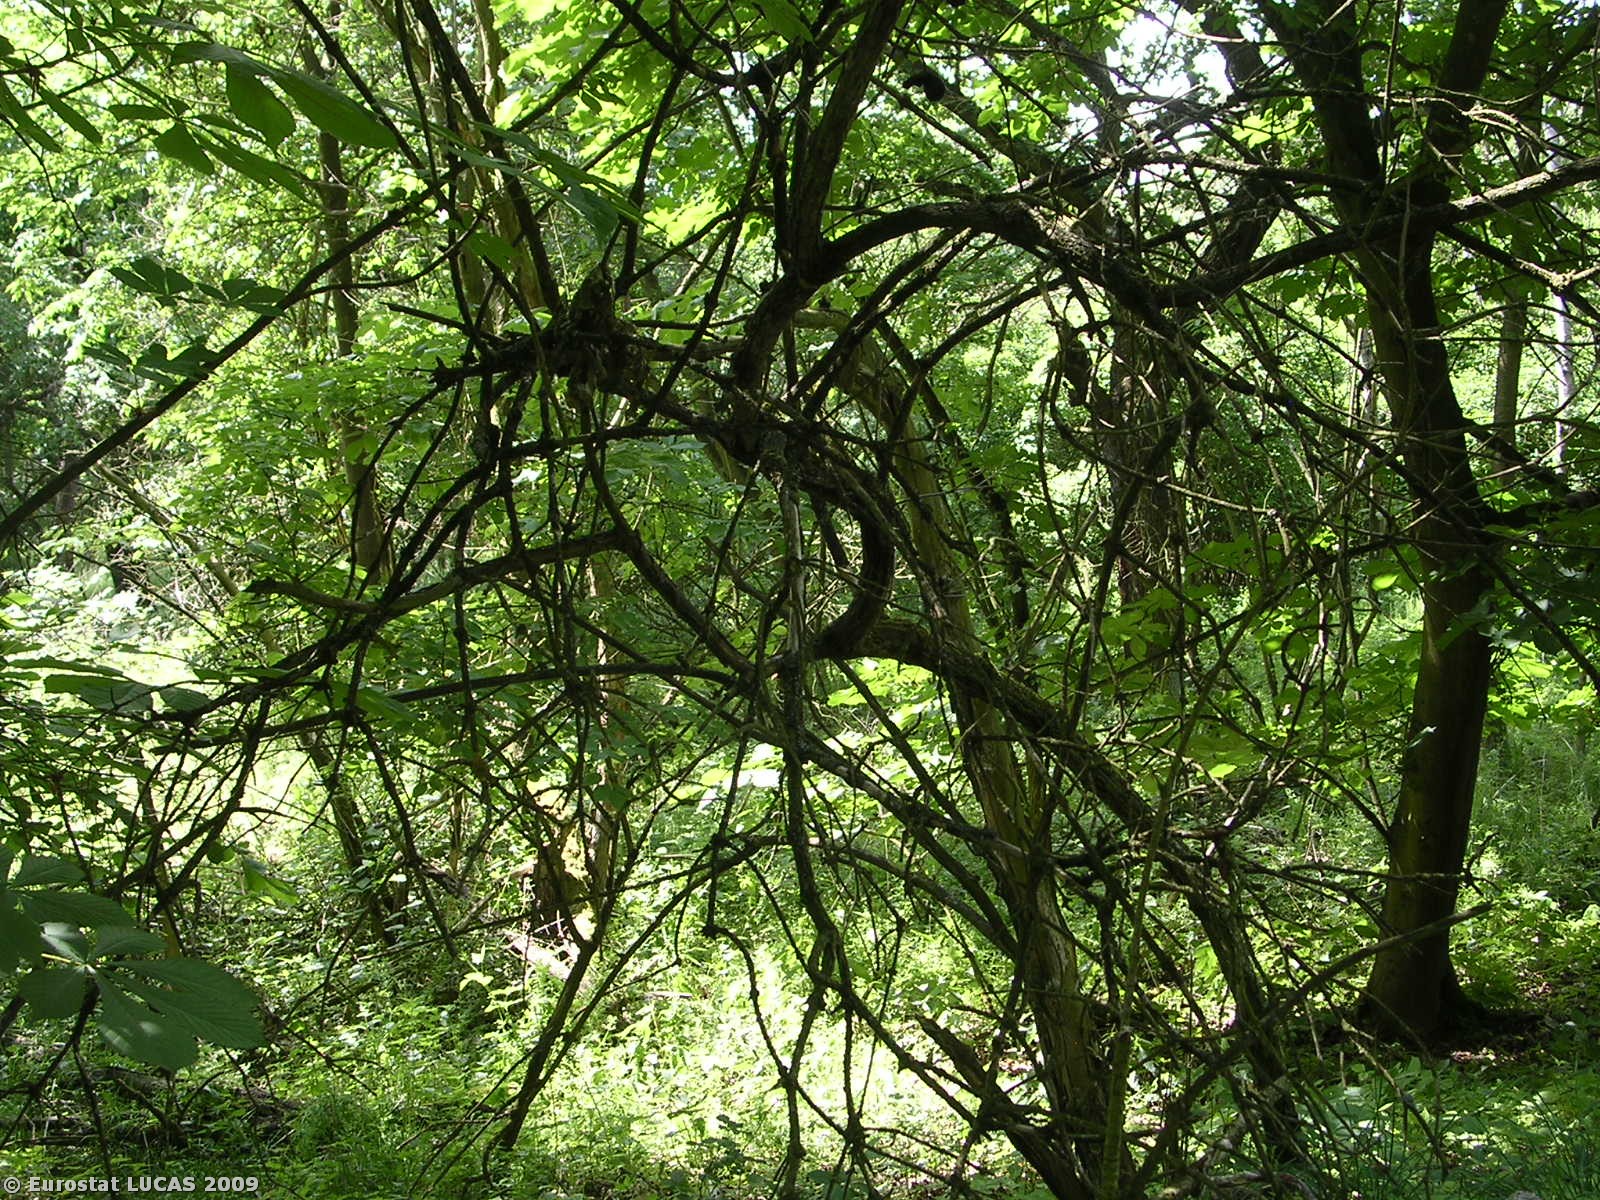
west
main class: Woodland
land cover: Broadleaved woodland
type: hemiboreal forest and nemoral coniferous forest and mixed broadleaved-coniferous forest
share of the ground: > 75 %
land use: Unused
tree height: > 5 m
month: May
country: CZ
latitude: 50.2400
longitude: 14.9241
